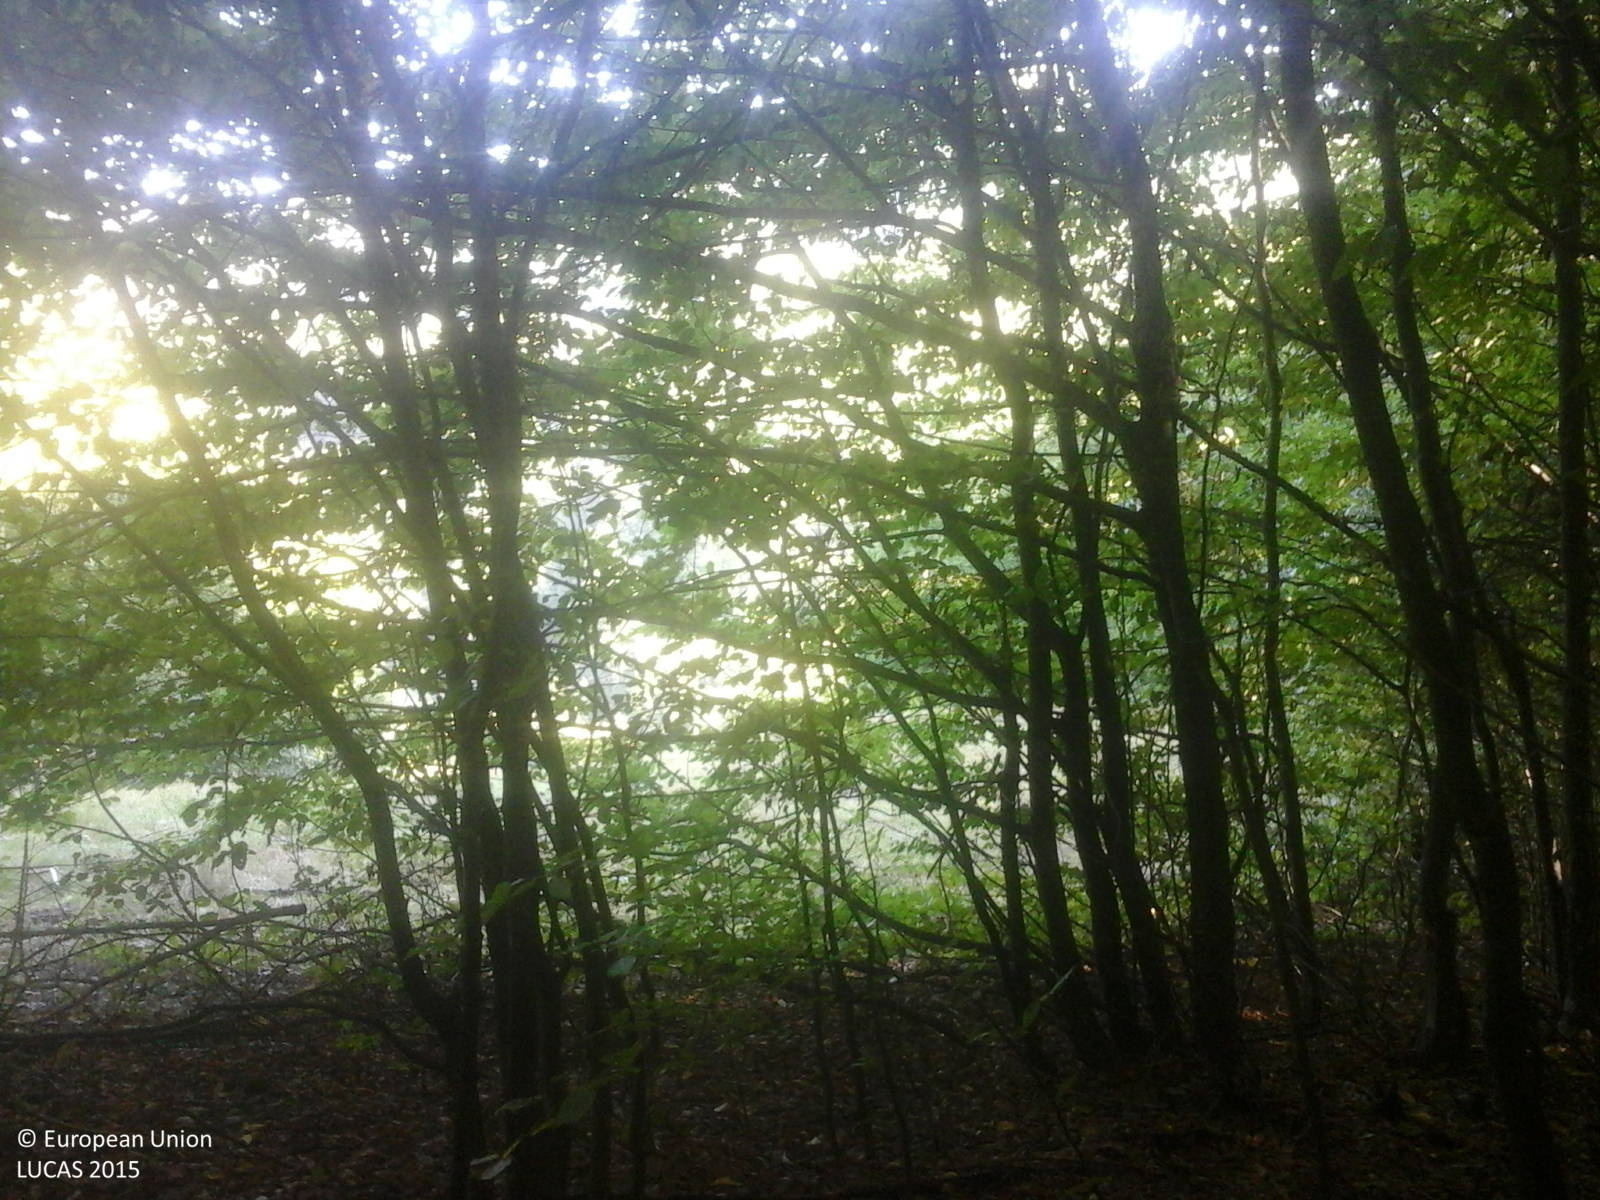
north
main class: Woodland
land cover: Broadleaved woodland
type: mesophytic deciduous forest
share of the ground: > 75 %
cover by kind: broadleaved forest trees 100 %
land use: Forestry
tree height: > 5 m
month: September
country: RO
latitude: 46.7854
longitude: 22.4571
